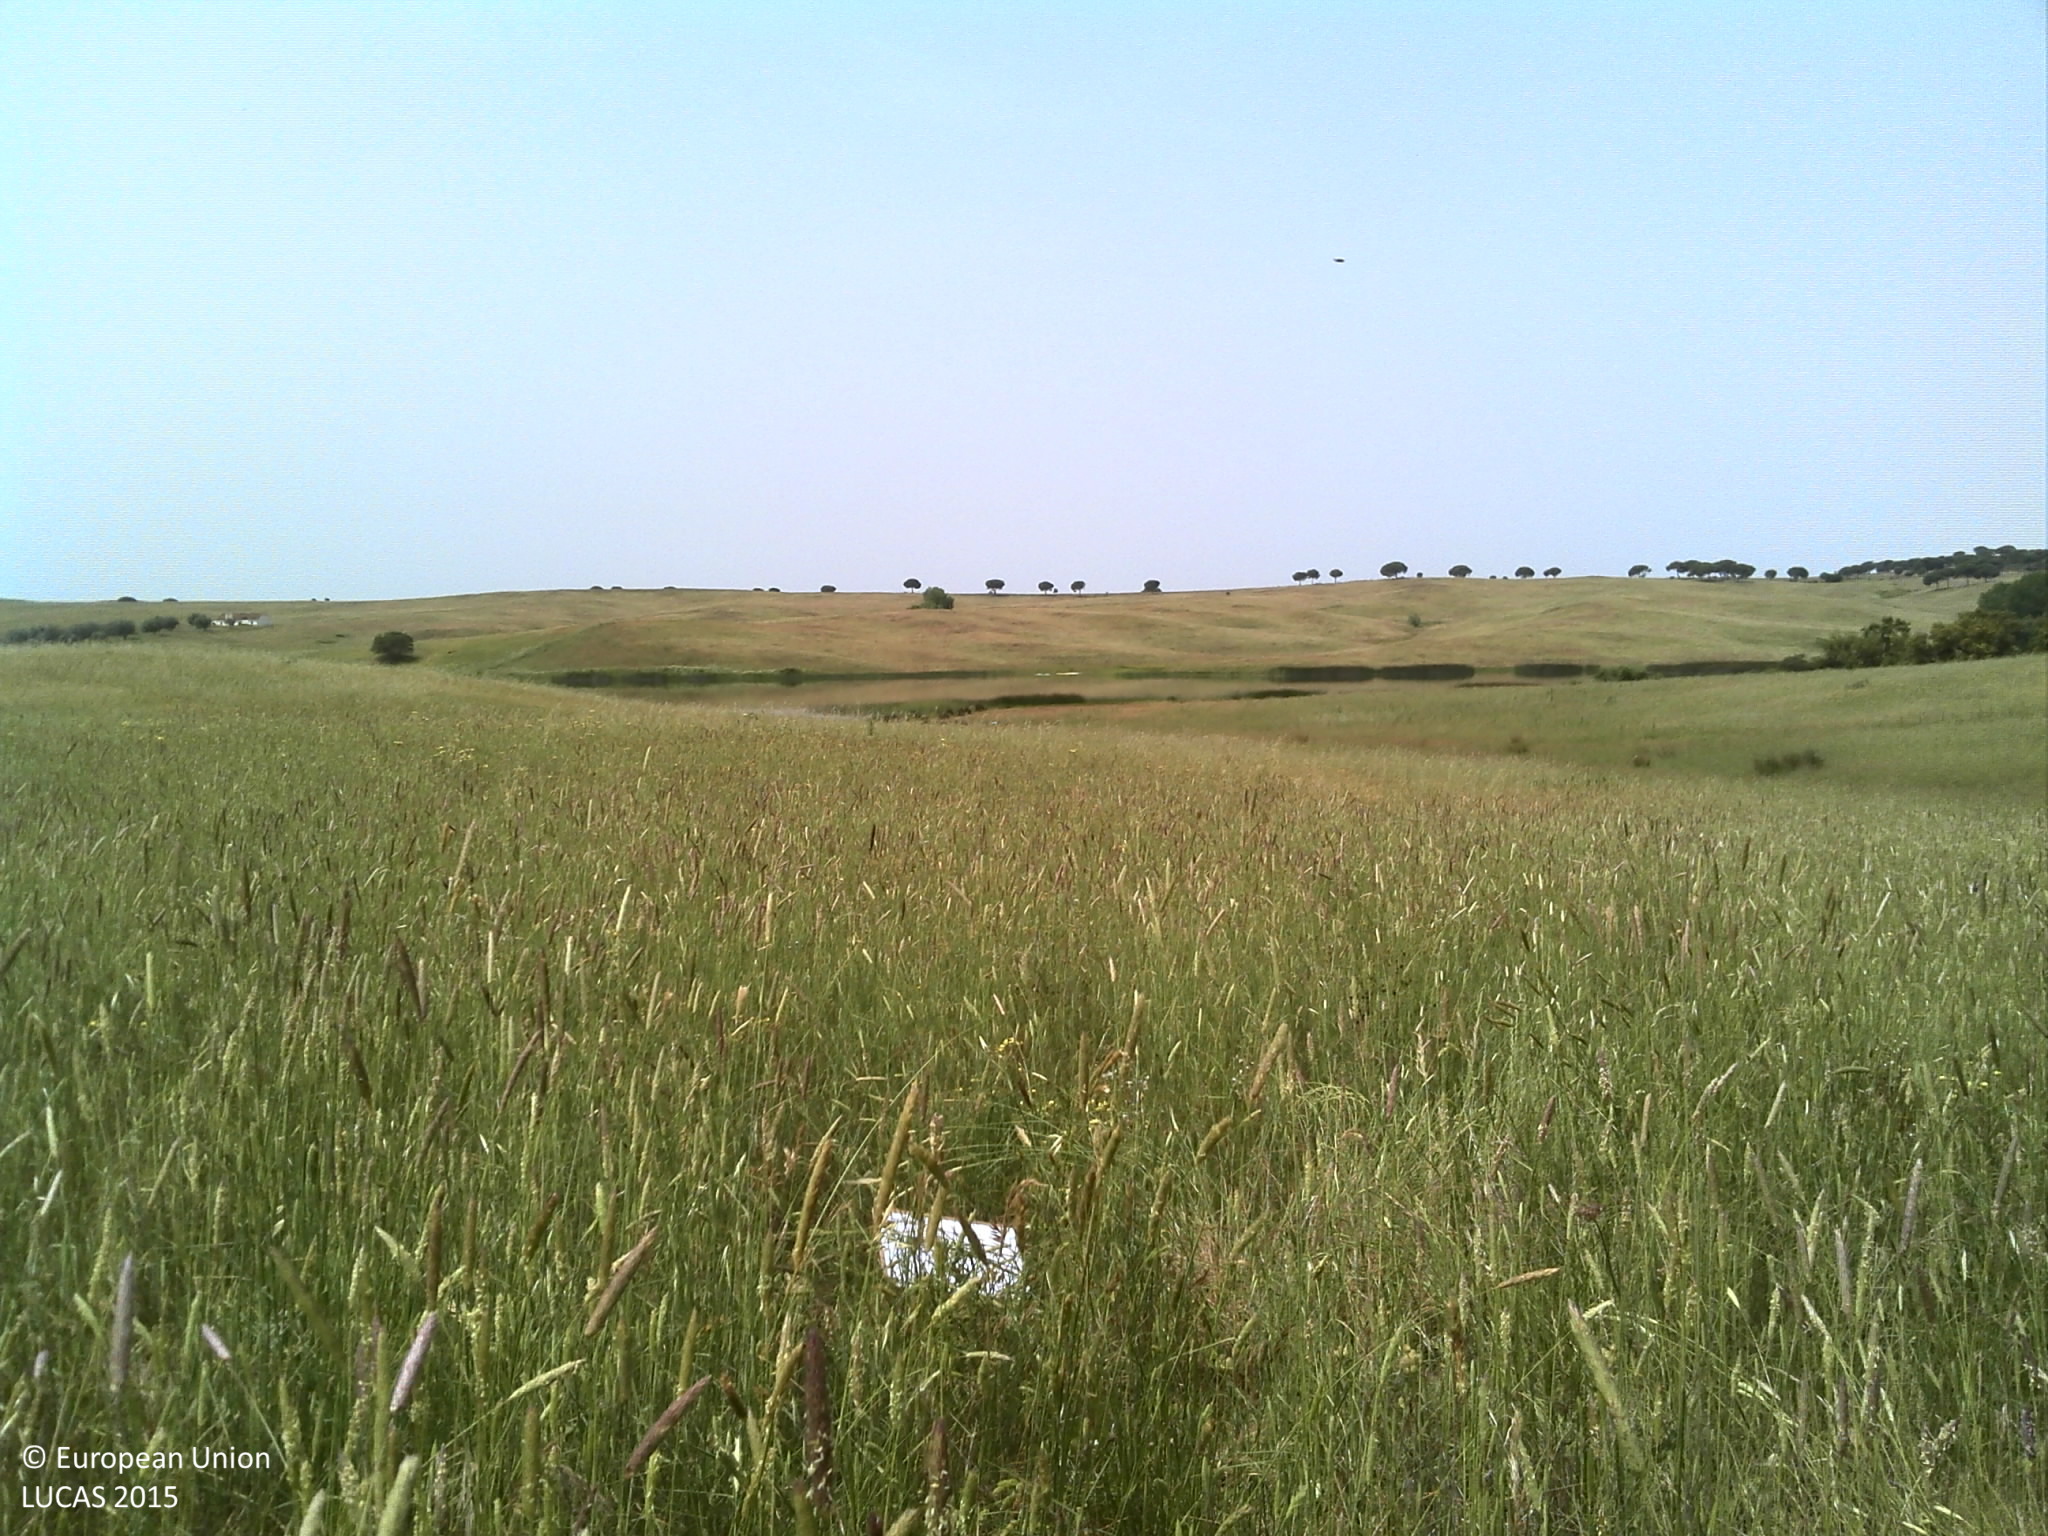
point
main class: Grassland
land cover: Spontaneously vegetated surfaces
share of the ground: > 75 %
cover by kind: herbaceous plants 75 %, unconsolidated bare surface 25 %
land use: Agriculture (excluding fallow land and kitchen gardens)
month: May
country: PT
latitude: 38.4642
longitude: -8.4453
